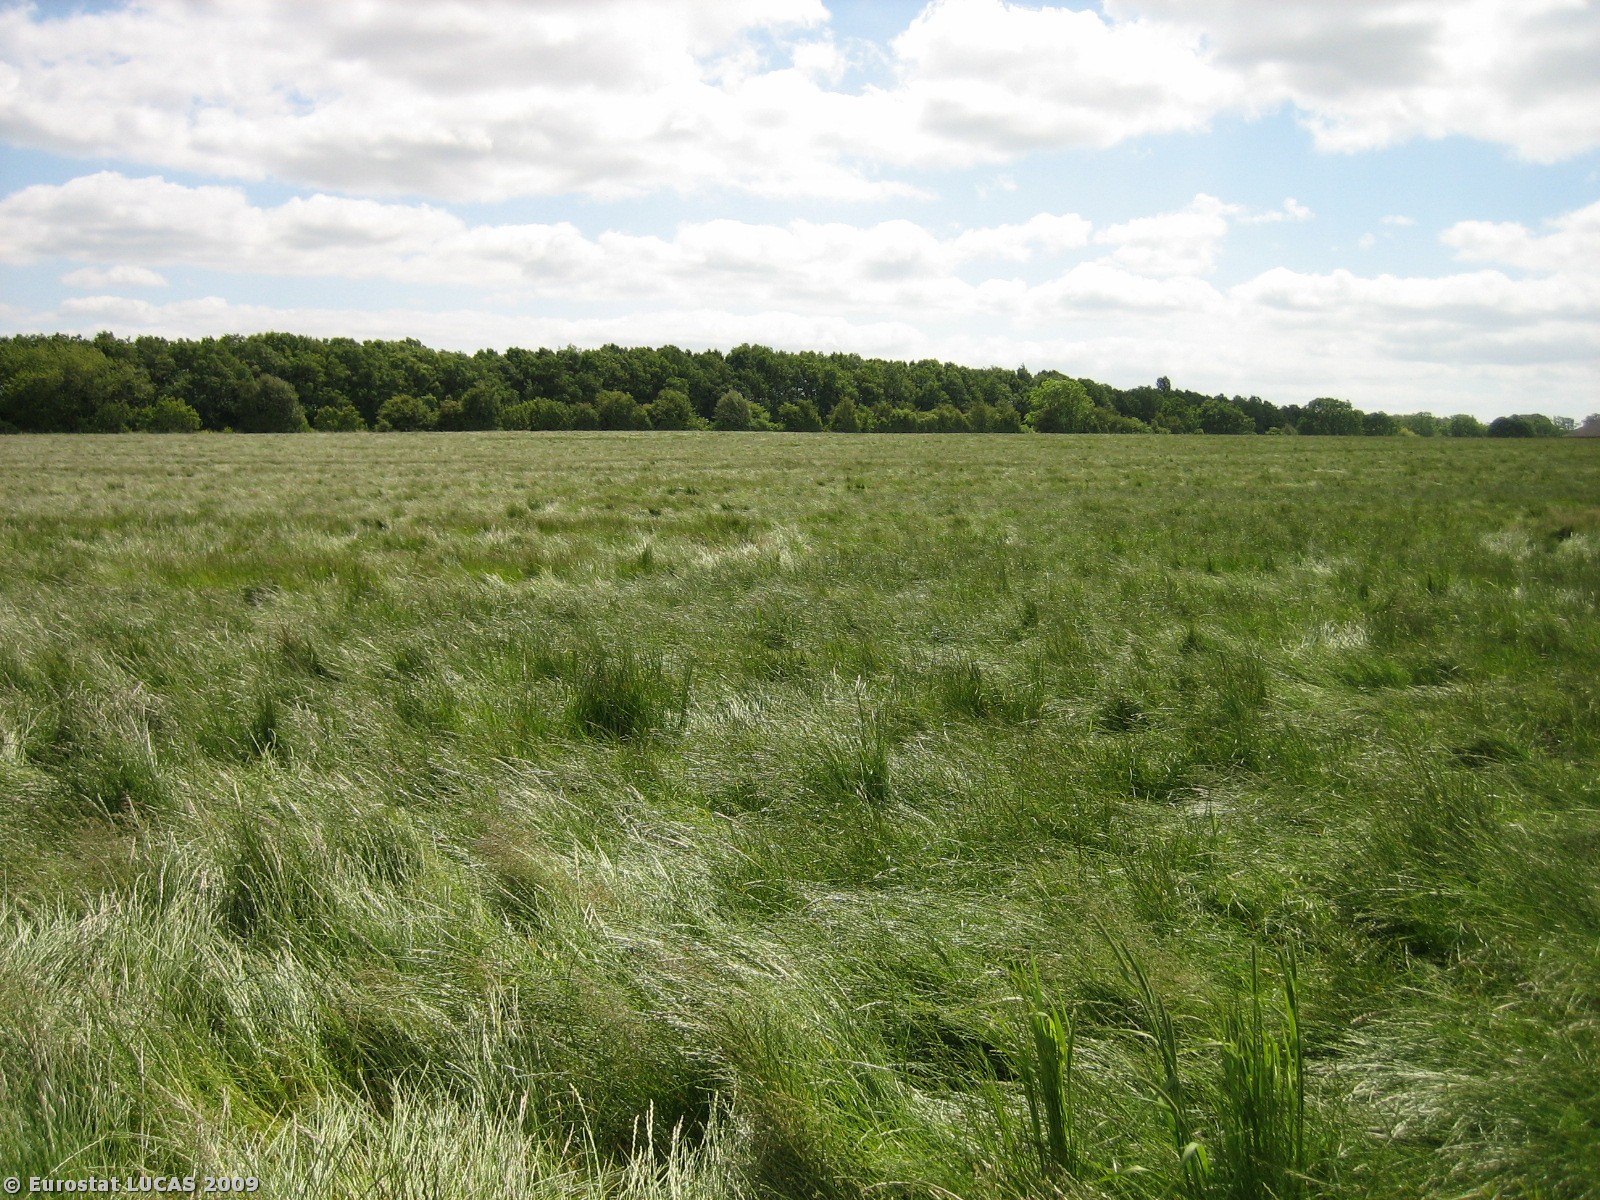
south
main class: Artificial land
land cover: Non built-up linear features
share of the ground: > 75 %
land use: Residential
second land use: Road transport
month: June
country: DK
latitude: 55.8279
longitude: 9.7289
